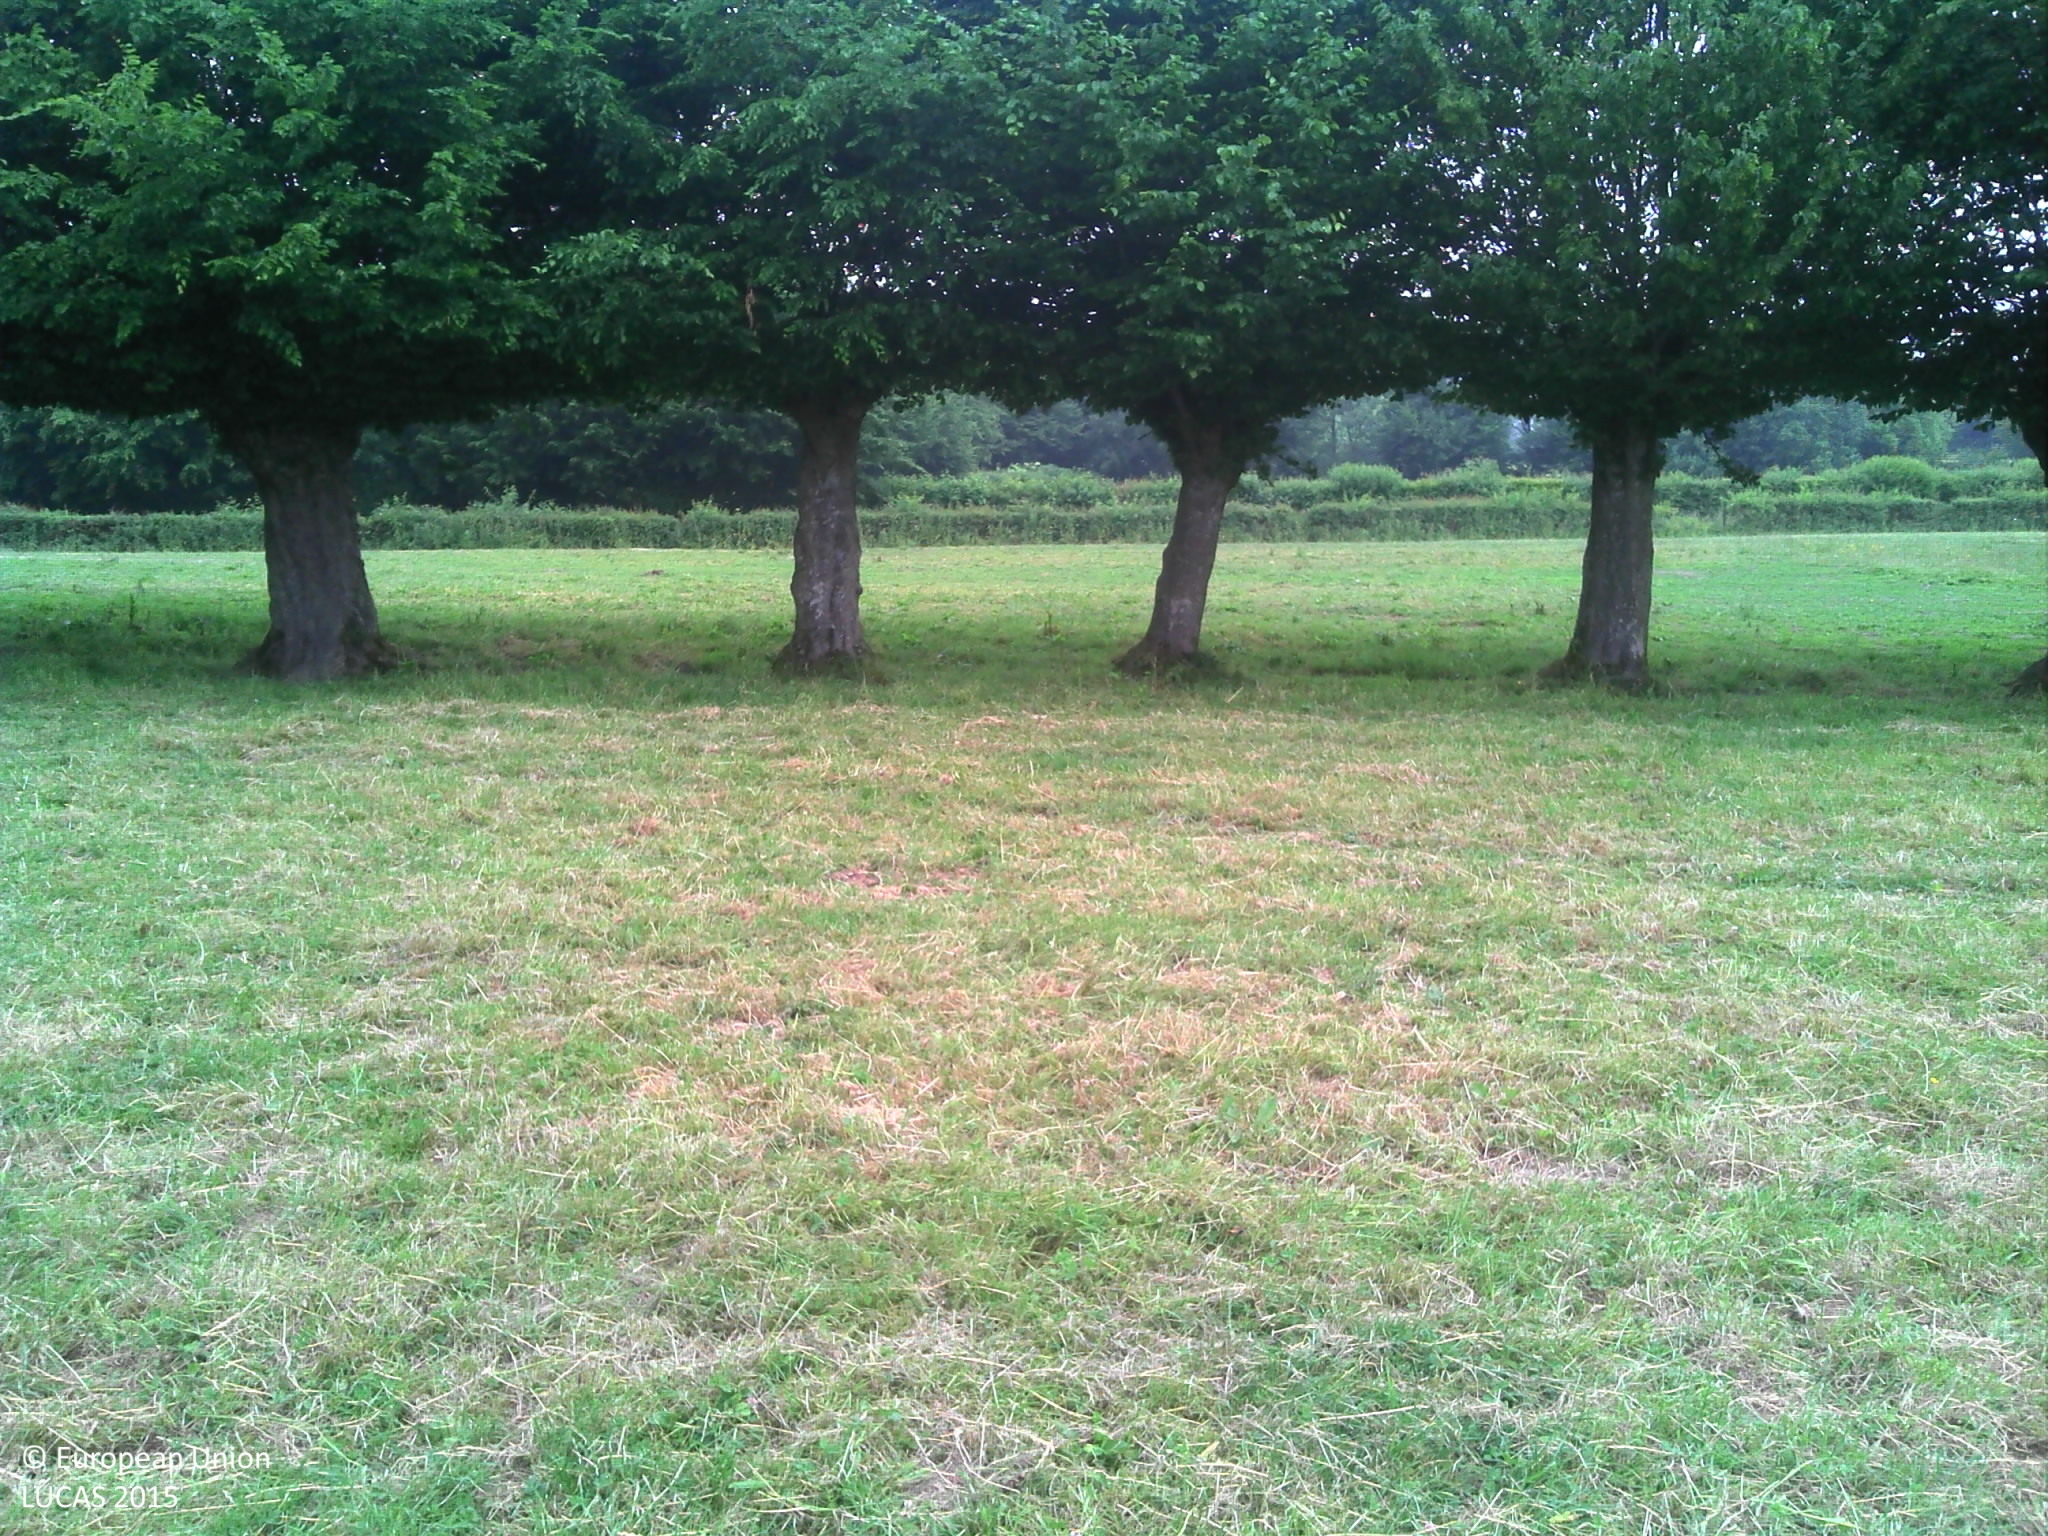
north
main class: Grassland
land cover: Grassland without tree/shrub cover
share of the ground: > 75 %
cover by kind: herbaceous plants 100 %
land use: Agriculture (excluding fallow land and kitchen gardens)
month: June
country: FR
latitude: 50.0072
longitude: 3.9805
